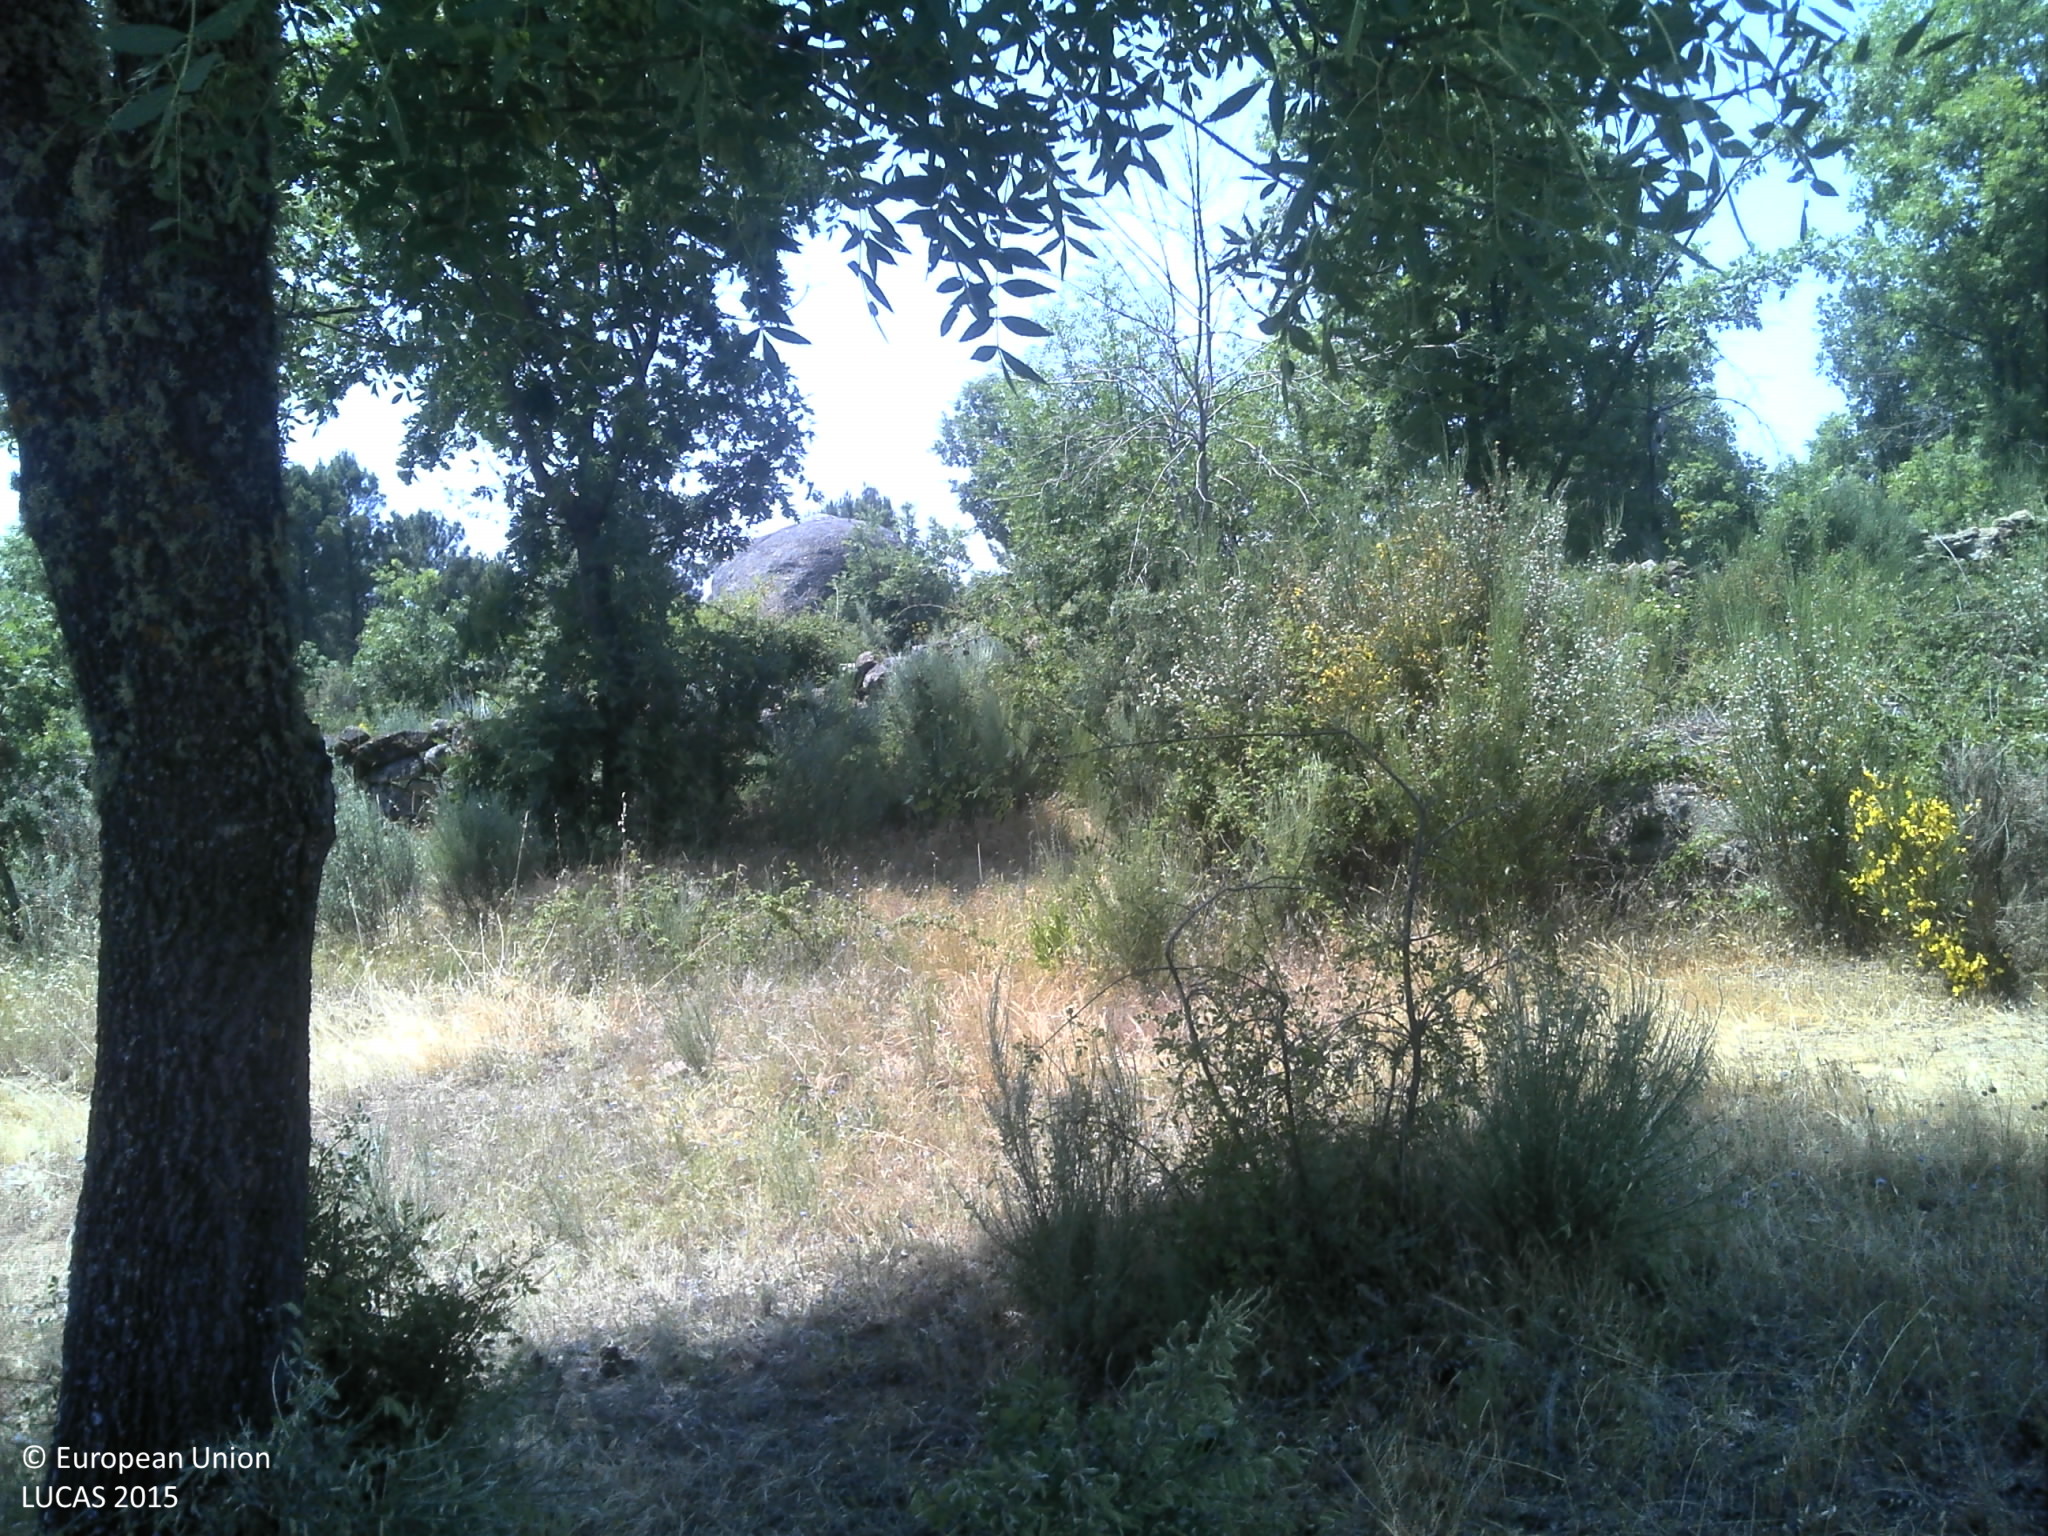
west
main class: Grassland
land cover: Grassland with sparse tree/shrub cover
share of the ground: 50 - 75 %
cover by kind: herbaceous plants 75 %, unconsolidated bare surface 20 %, broadleaved forest trees 5 %
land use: Agriculture (excluding fallow land and kitchen gardens)
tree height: > 5 m
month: June
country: PT
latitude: 40.3726
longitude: -6.8046
